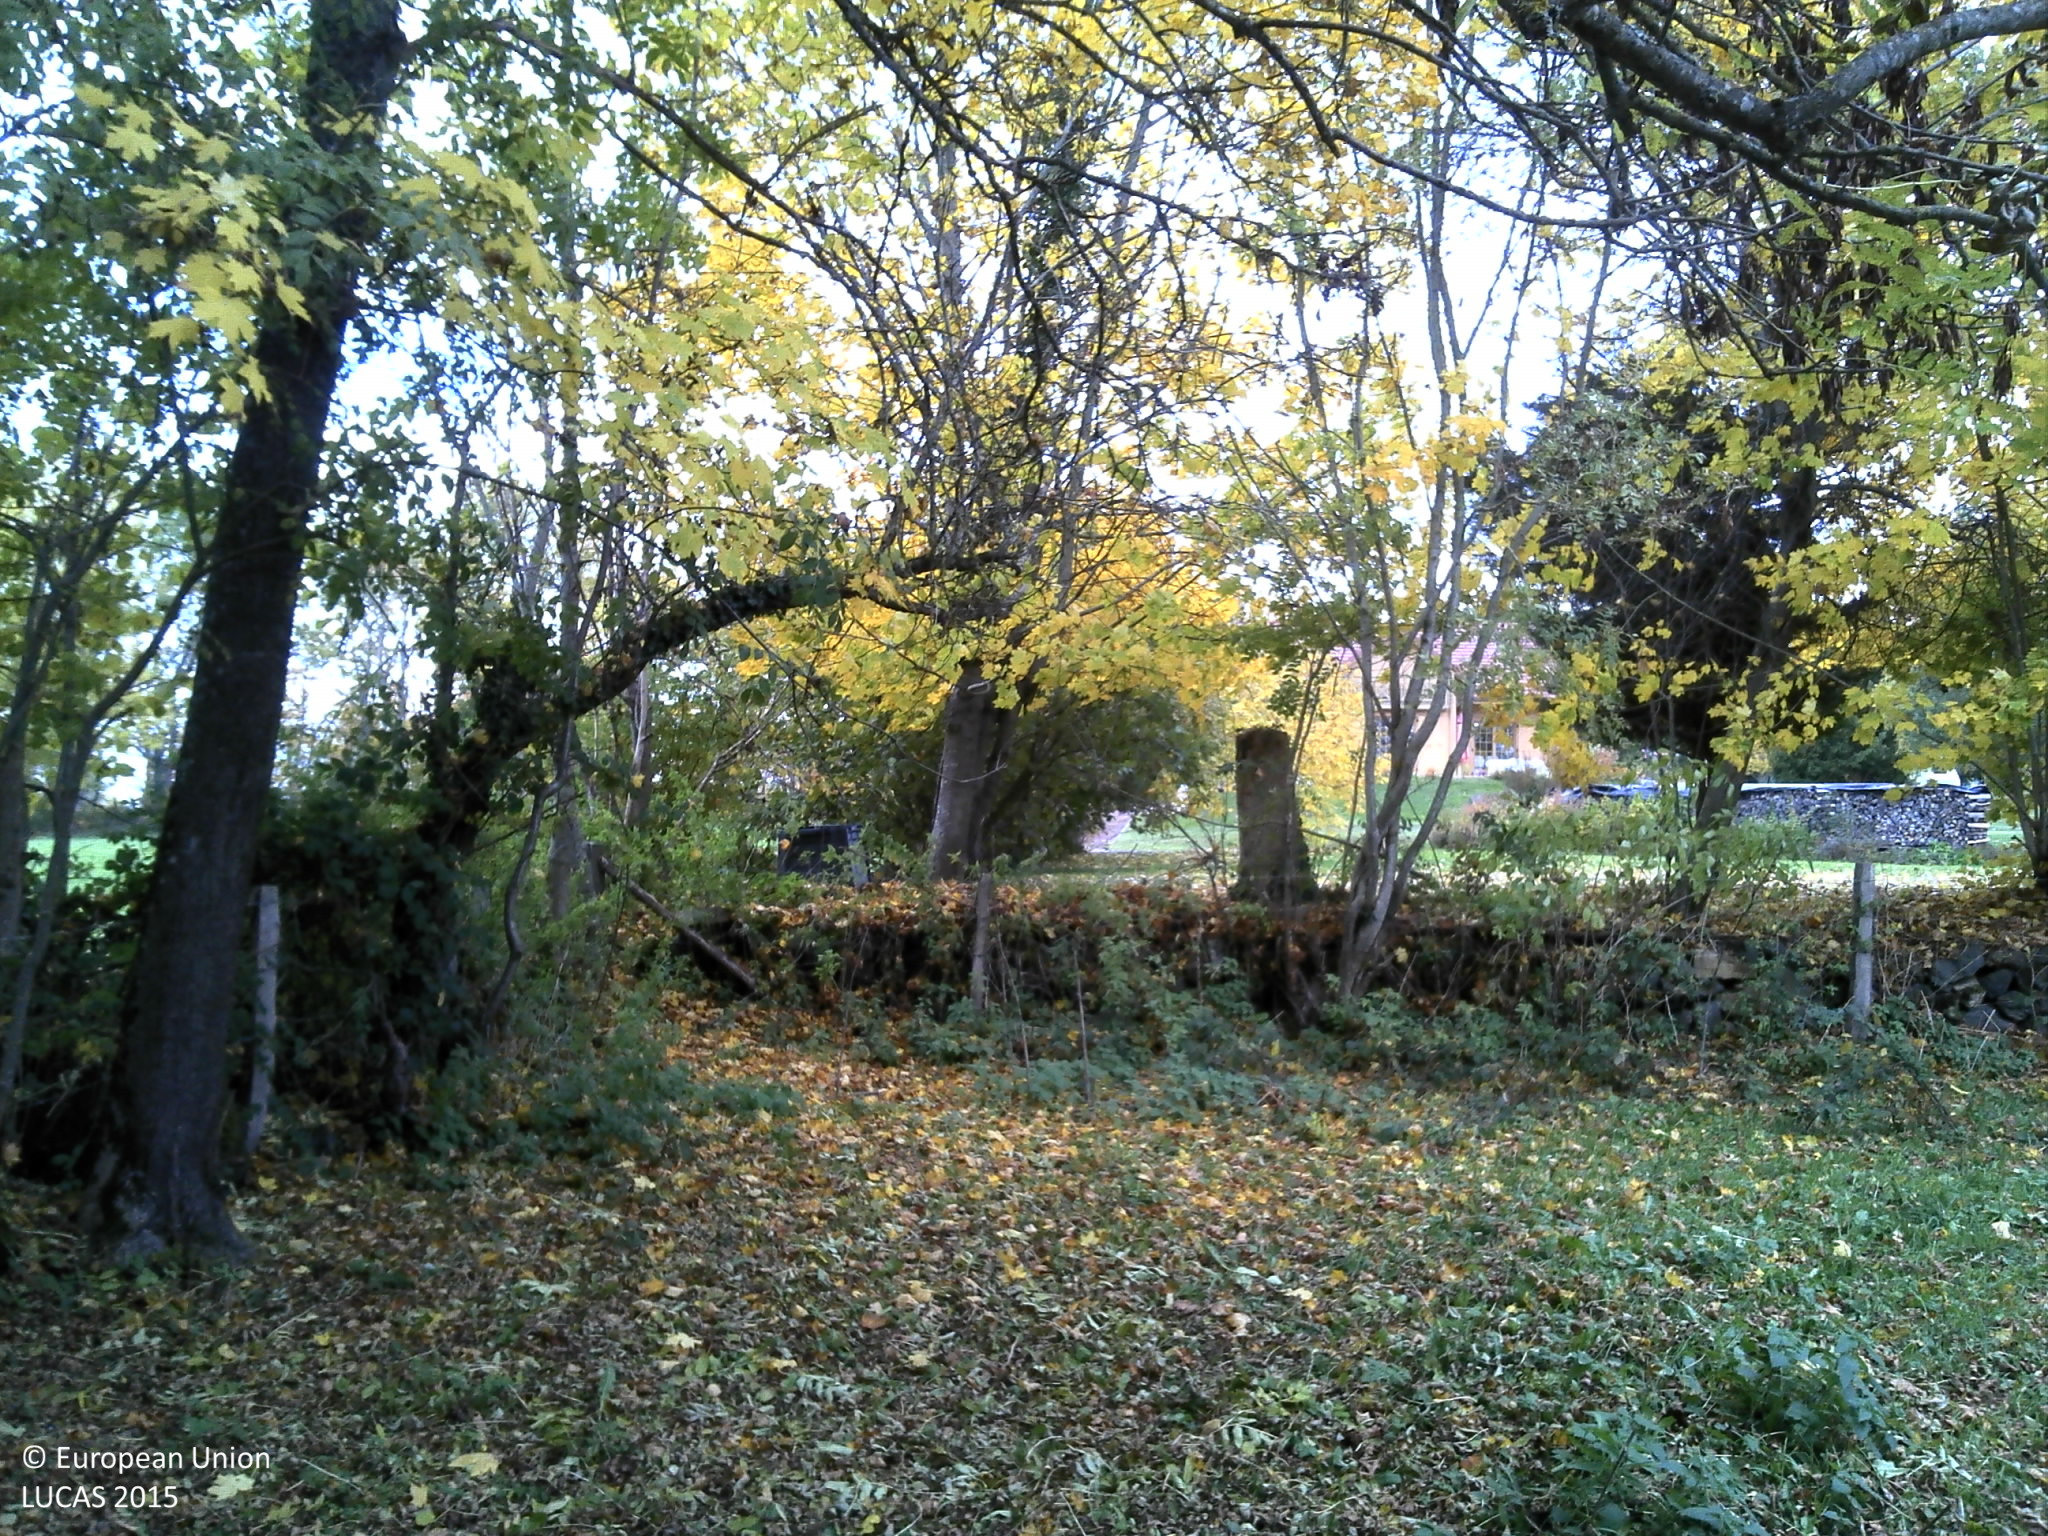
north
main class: Woodland
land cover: Broadleaved woodland
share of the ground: > 75 %
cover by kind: broadleaved forest trees 90 %, herbaceous plants 10 %
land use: Semi-natural and natural areas not in use
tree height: > 5 m
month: October
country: FR
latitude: 45.8049
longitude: 2.8575
